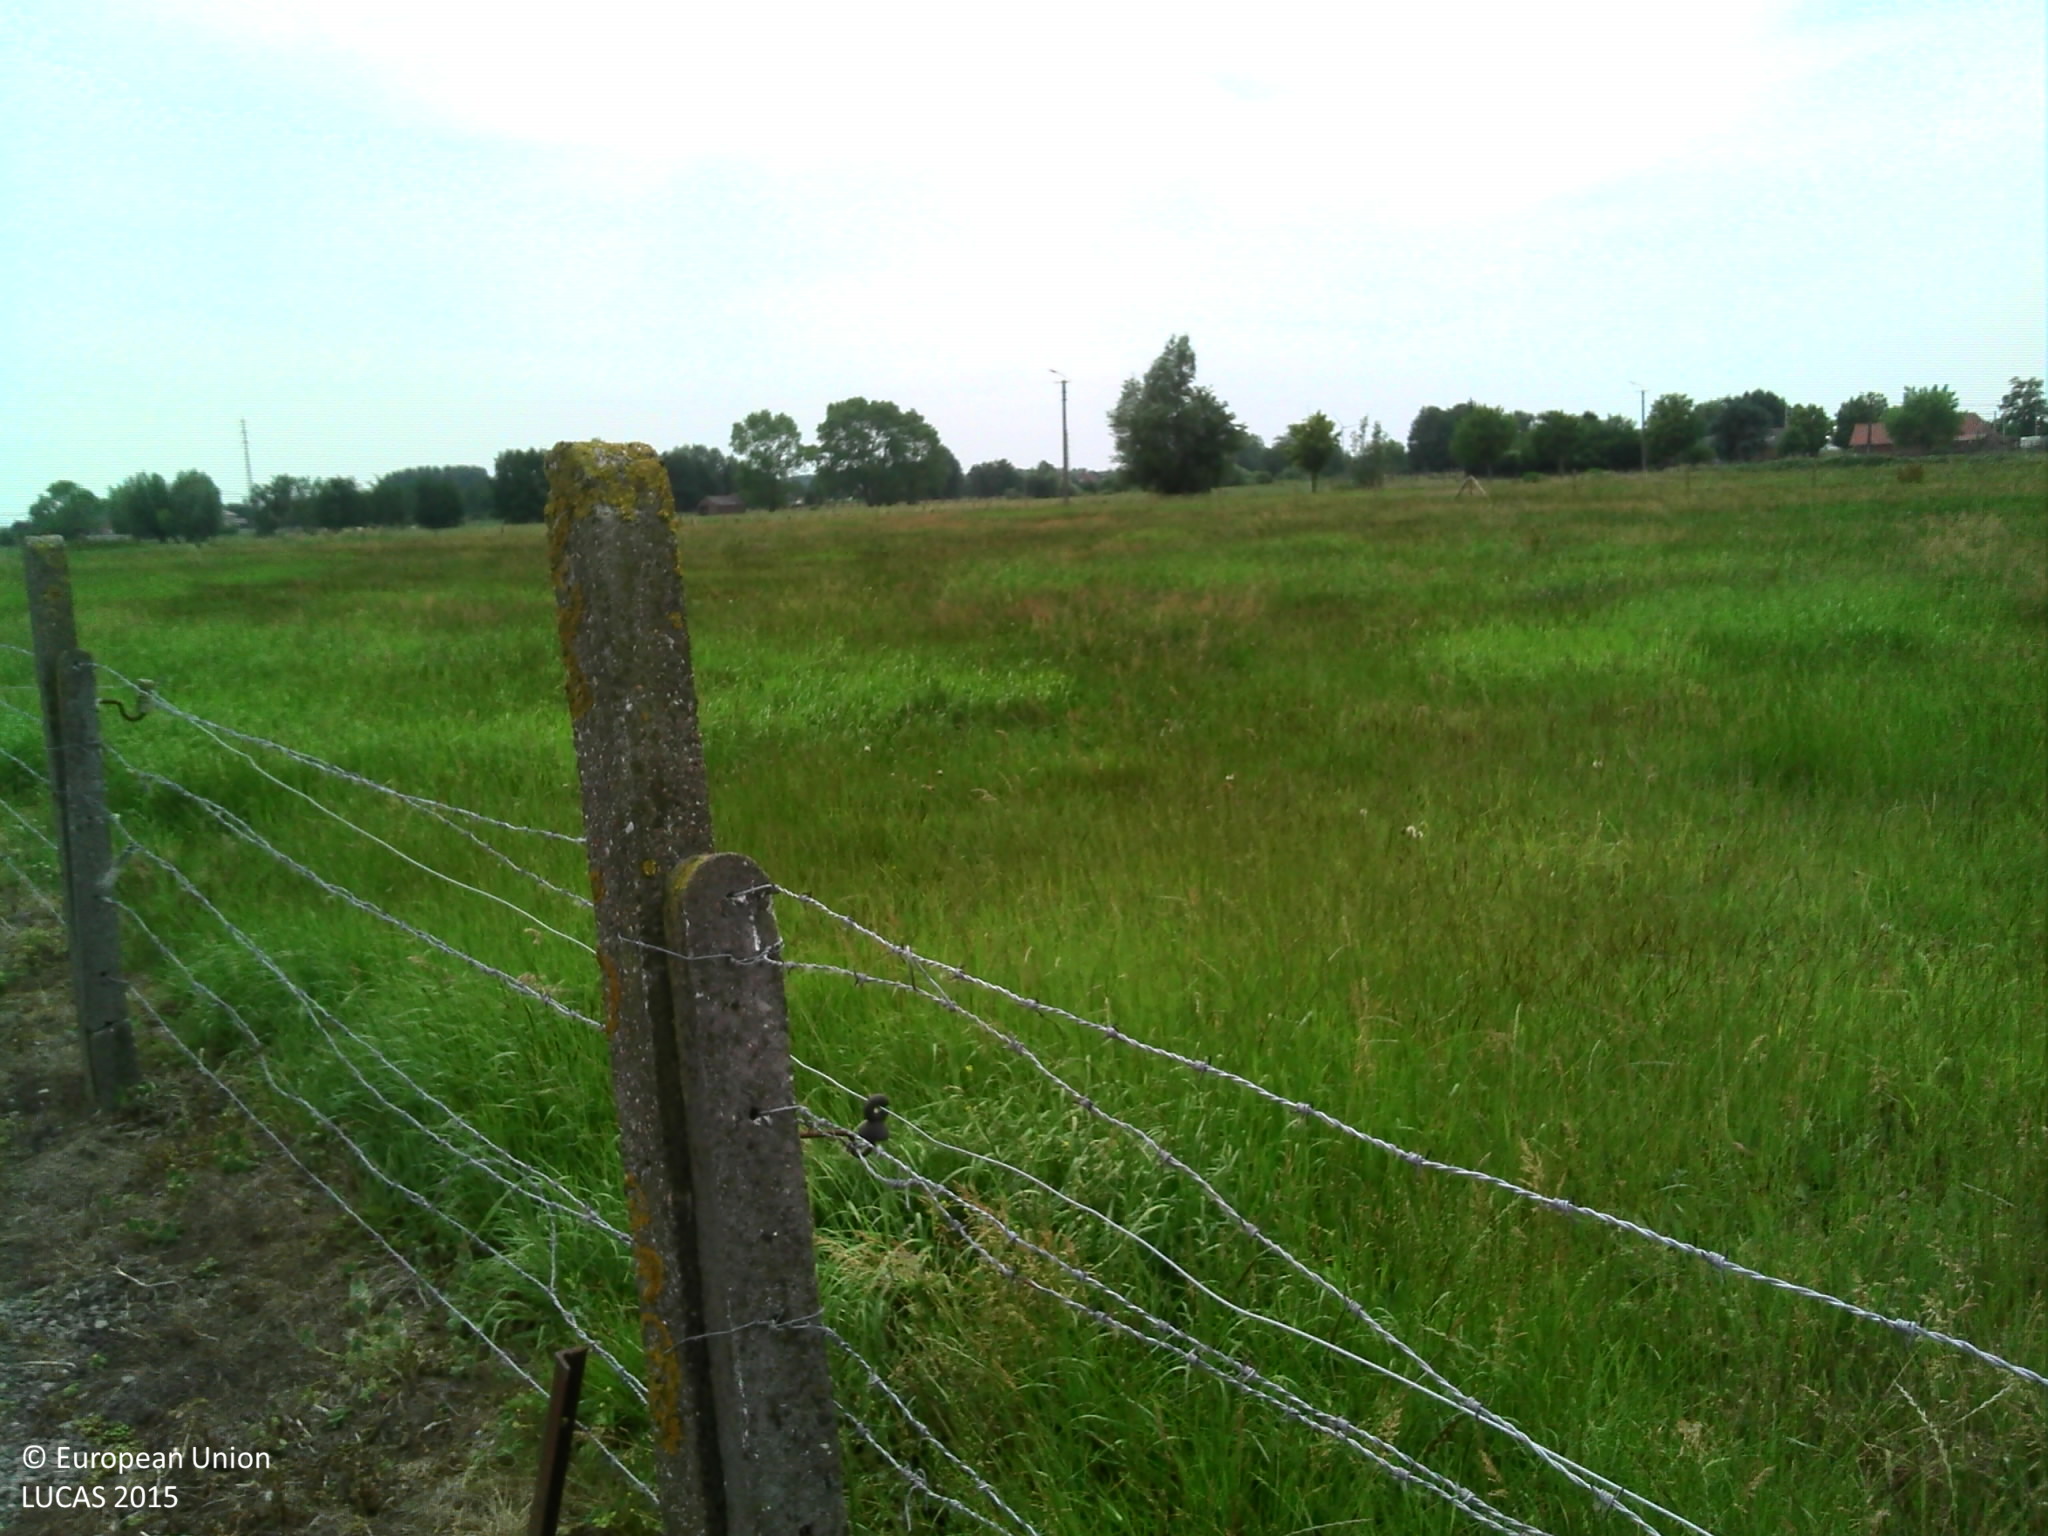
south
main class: Grassland
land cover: Grassland without tree/shrub cover
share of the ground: > 75 %
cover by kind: herbaceous plants 100 %
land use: Agriculture (excluding fallow land and kitchen gardens)
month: June
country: BE
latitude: 50.9509
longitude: 3.4297
